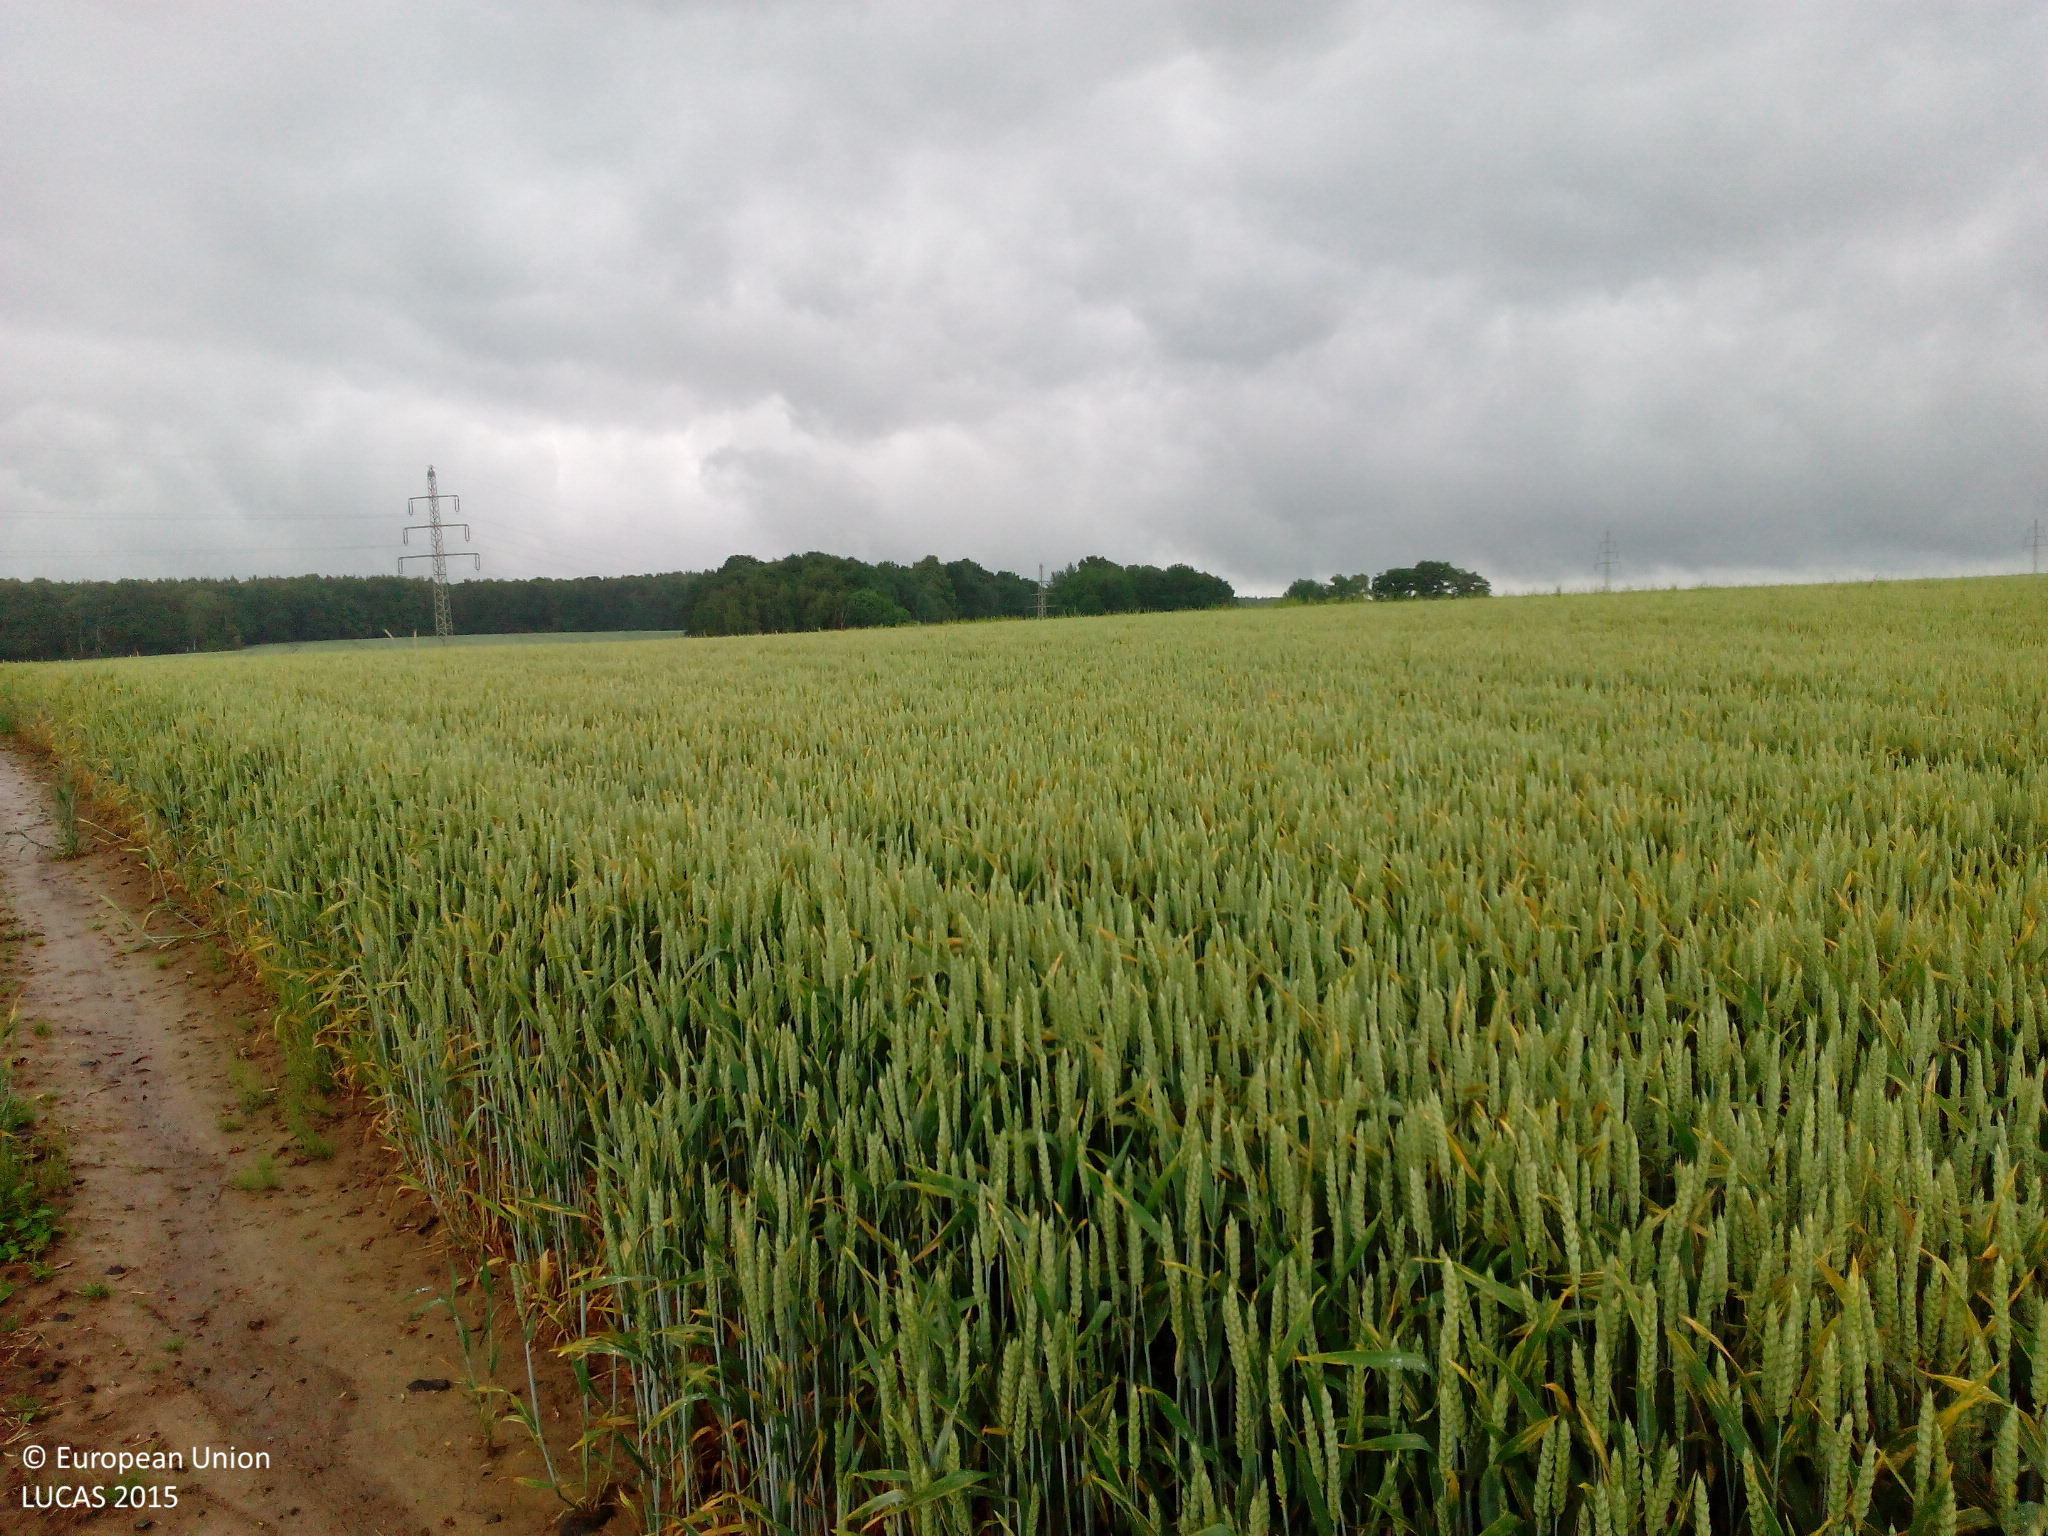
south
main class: Cropland
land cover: Common wheat
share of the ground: > 75 %
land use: Agriculture (excluding fallow land and kitchen gardens)
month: June
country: DE
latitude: 51.0060
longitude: 13.0927
